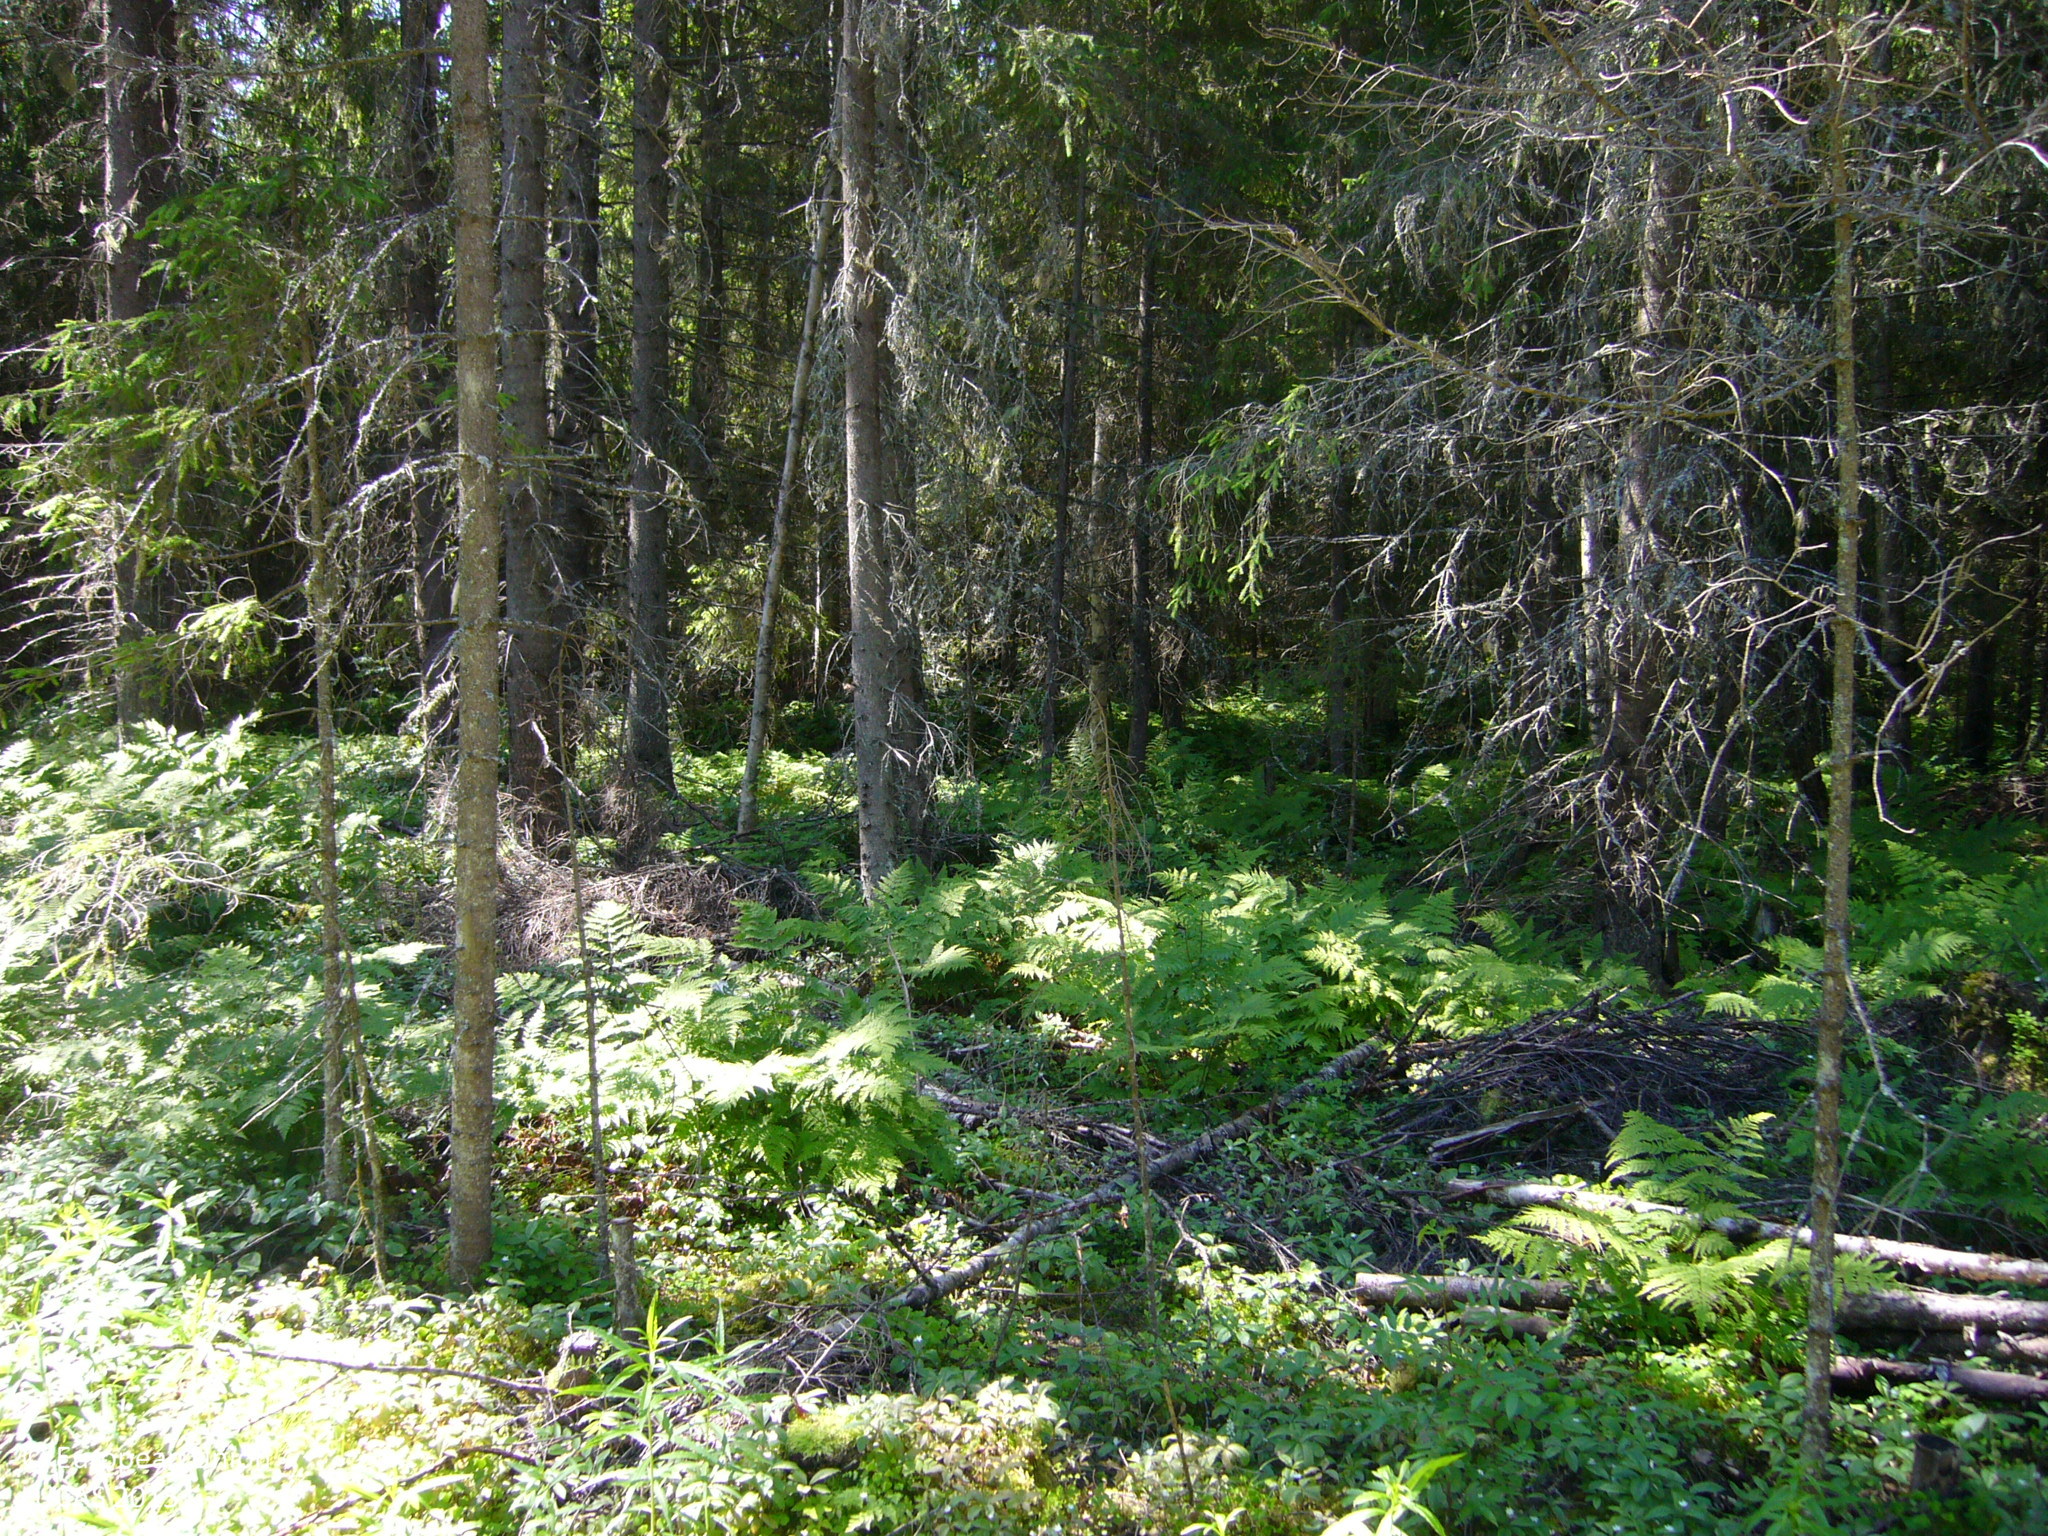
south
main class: Woodland
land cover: Spruce dominated coniferous woodland
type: boreal forest
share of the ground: > 75 %
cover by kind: coniferous forest trees 75 %, shrubs 20 %, broadleaved forest trees 5 %
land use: Forestry
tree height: > 5 m
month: June
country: FI
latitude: 63.8100
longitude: 26.2616
